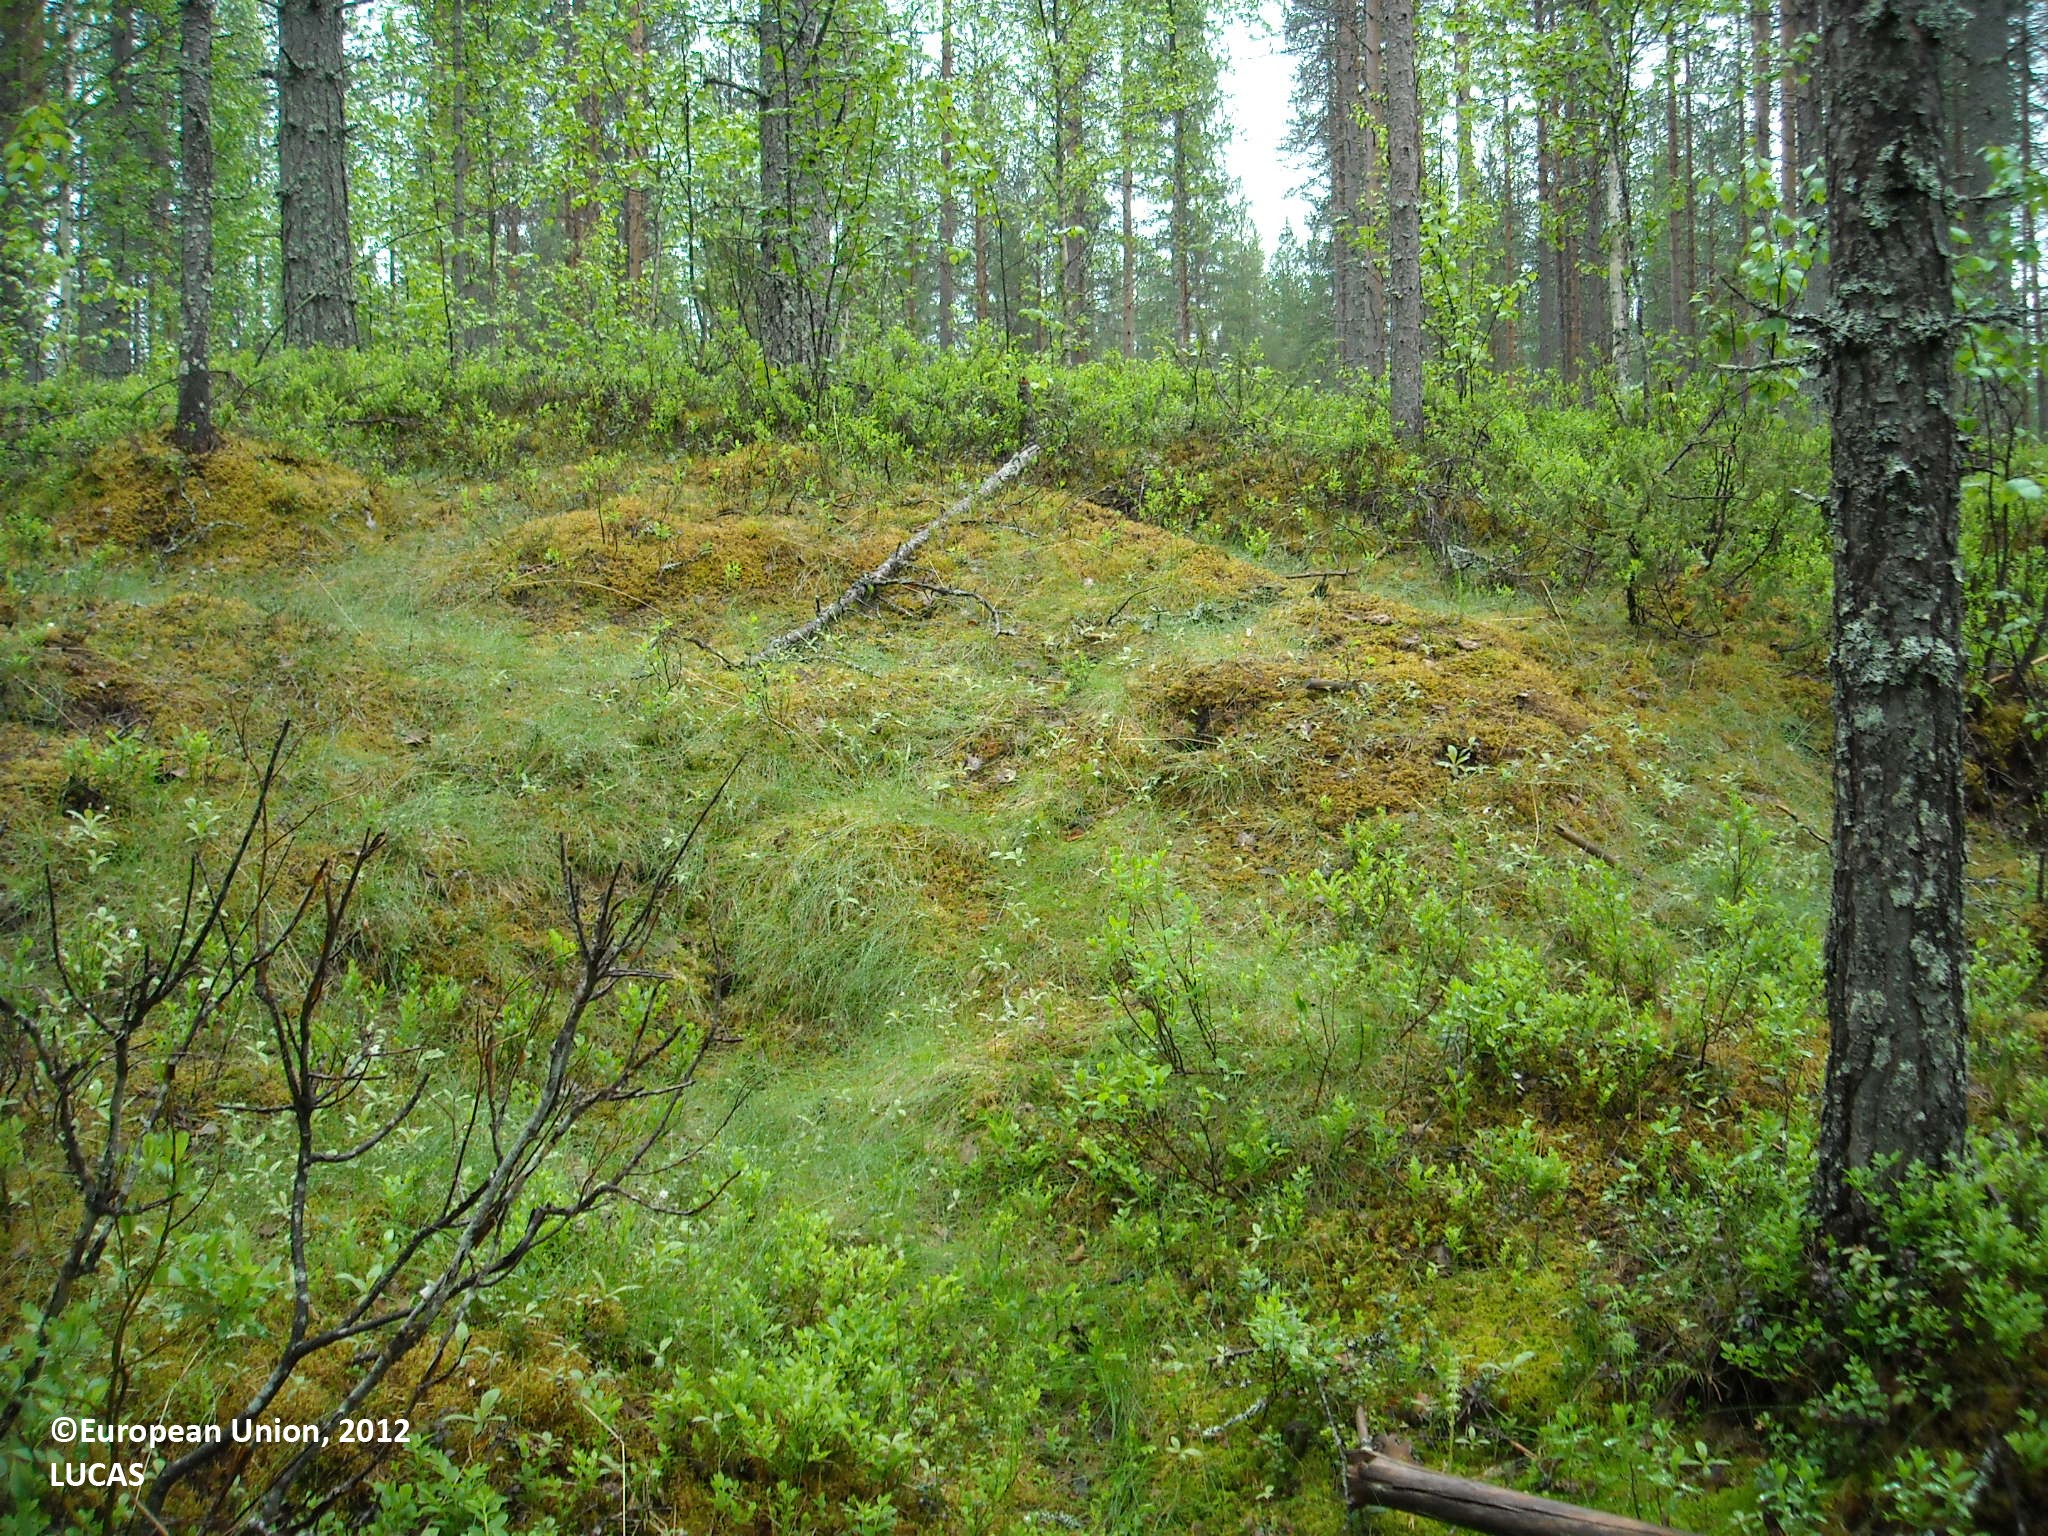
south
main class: Woodland
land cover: Pine dominated mixed woodland
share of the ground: > 75 %
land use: Forestry
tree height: > 5 m
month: June
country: FI
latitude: 65.4948
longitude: 27.8804
